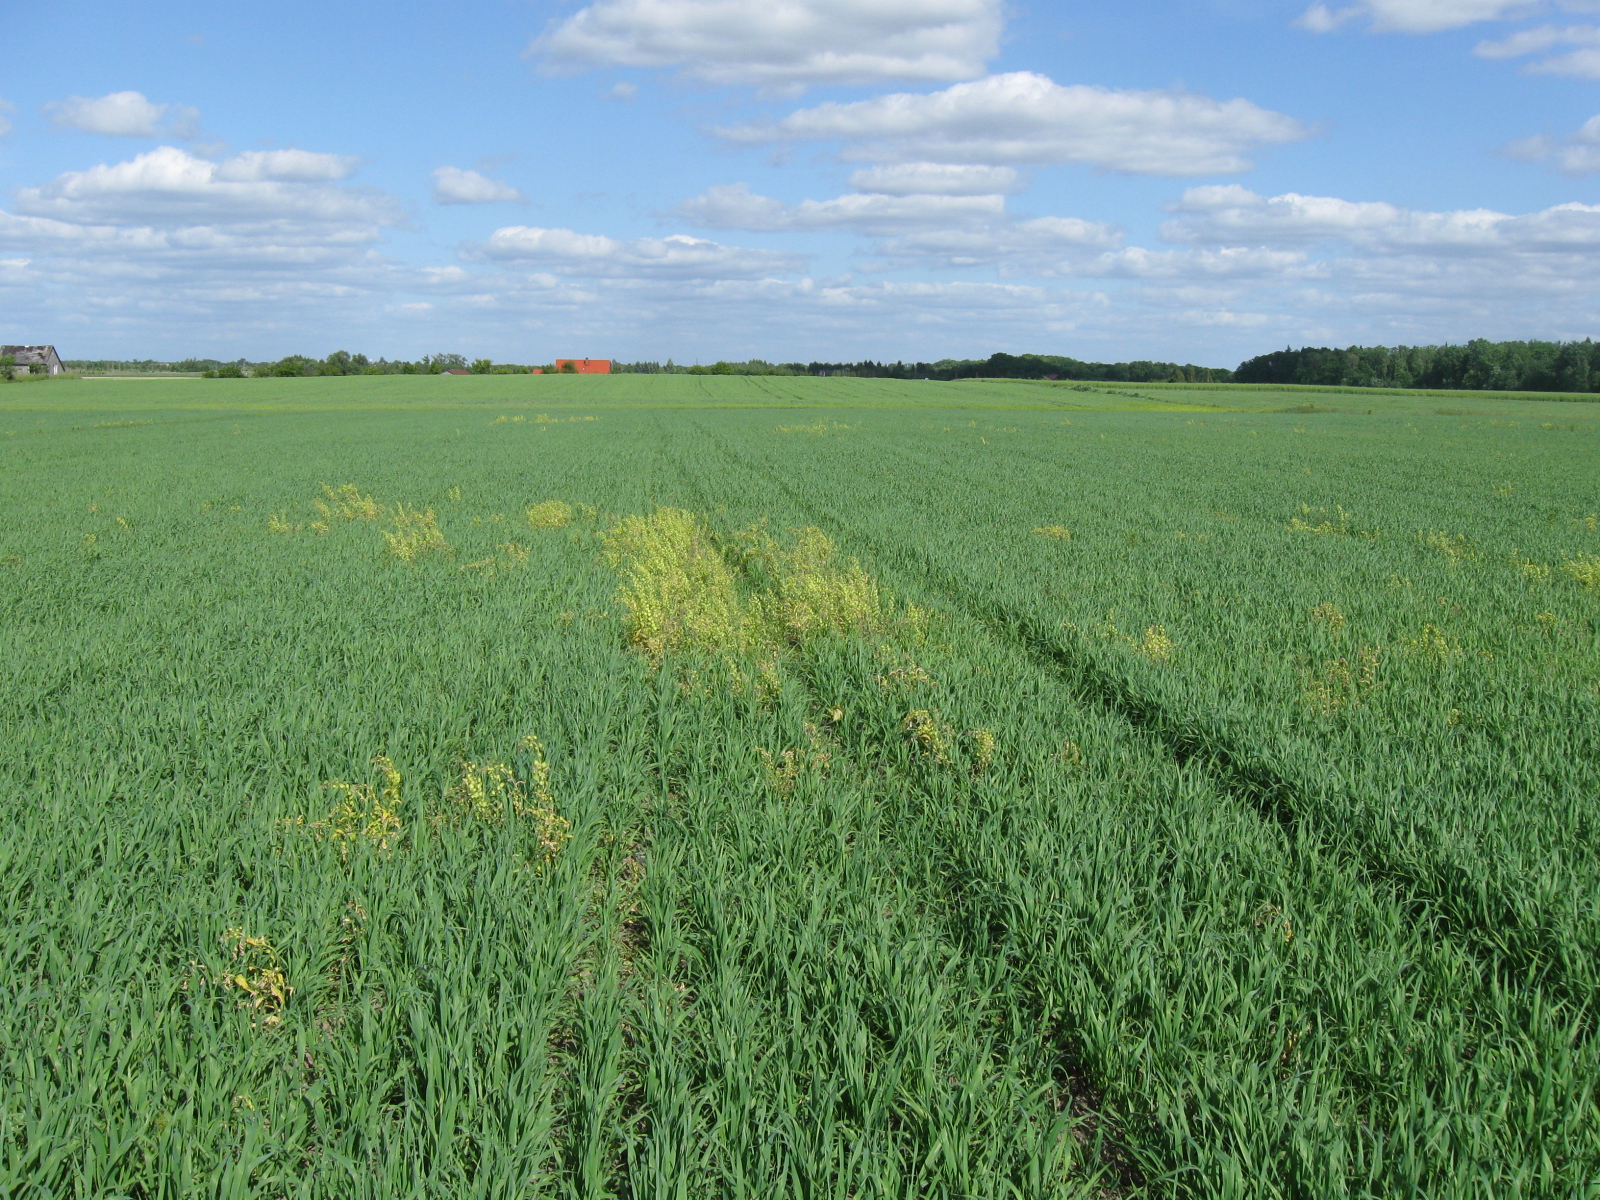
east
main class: Cropland
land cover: Oats
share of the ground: > 75 %
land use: Agriculture (excluding fallow land and kitchen gardens)
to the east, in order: Oats; Dry pulses
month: June
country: LT
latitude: 54.9674
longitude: 23.7535
